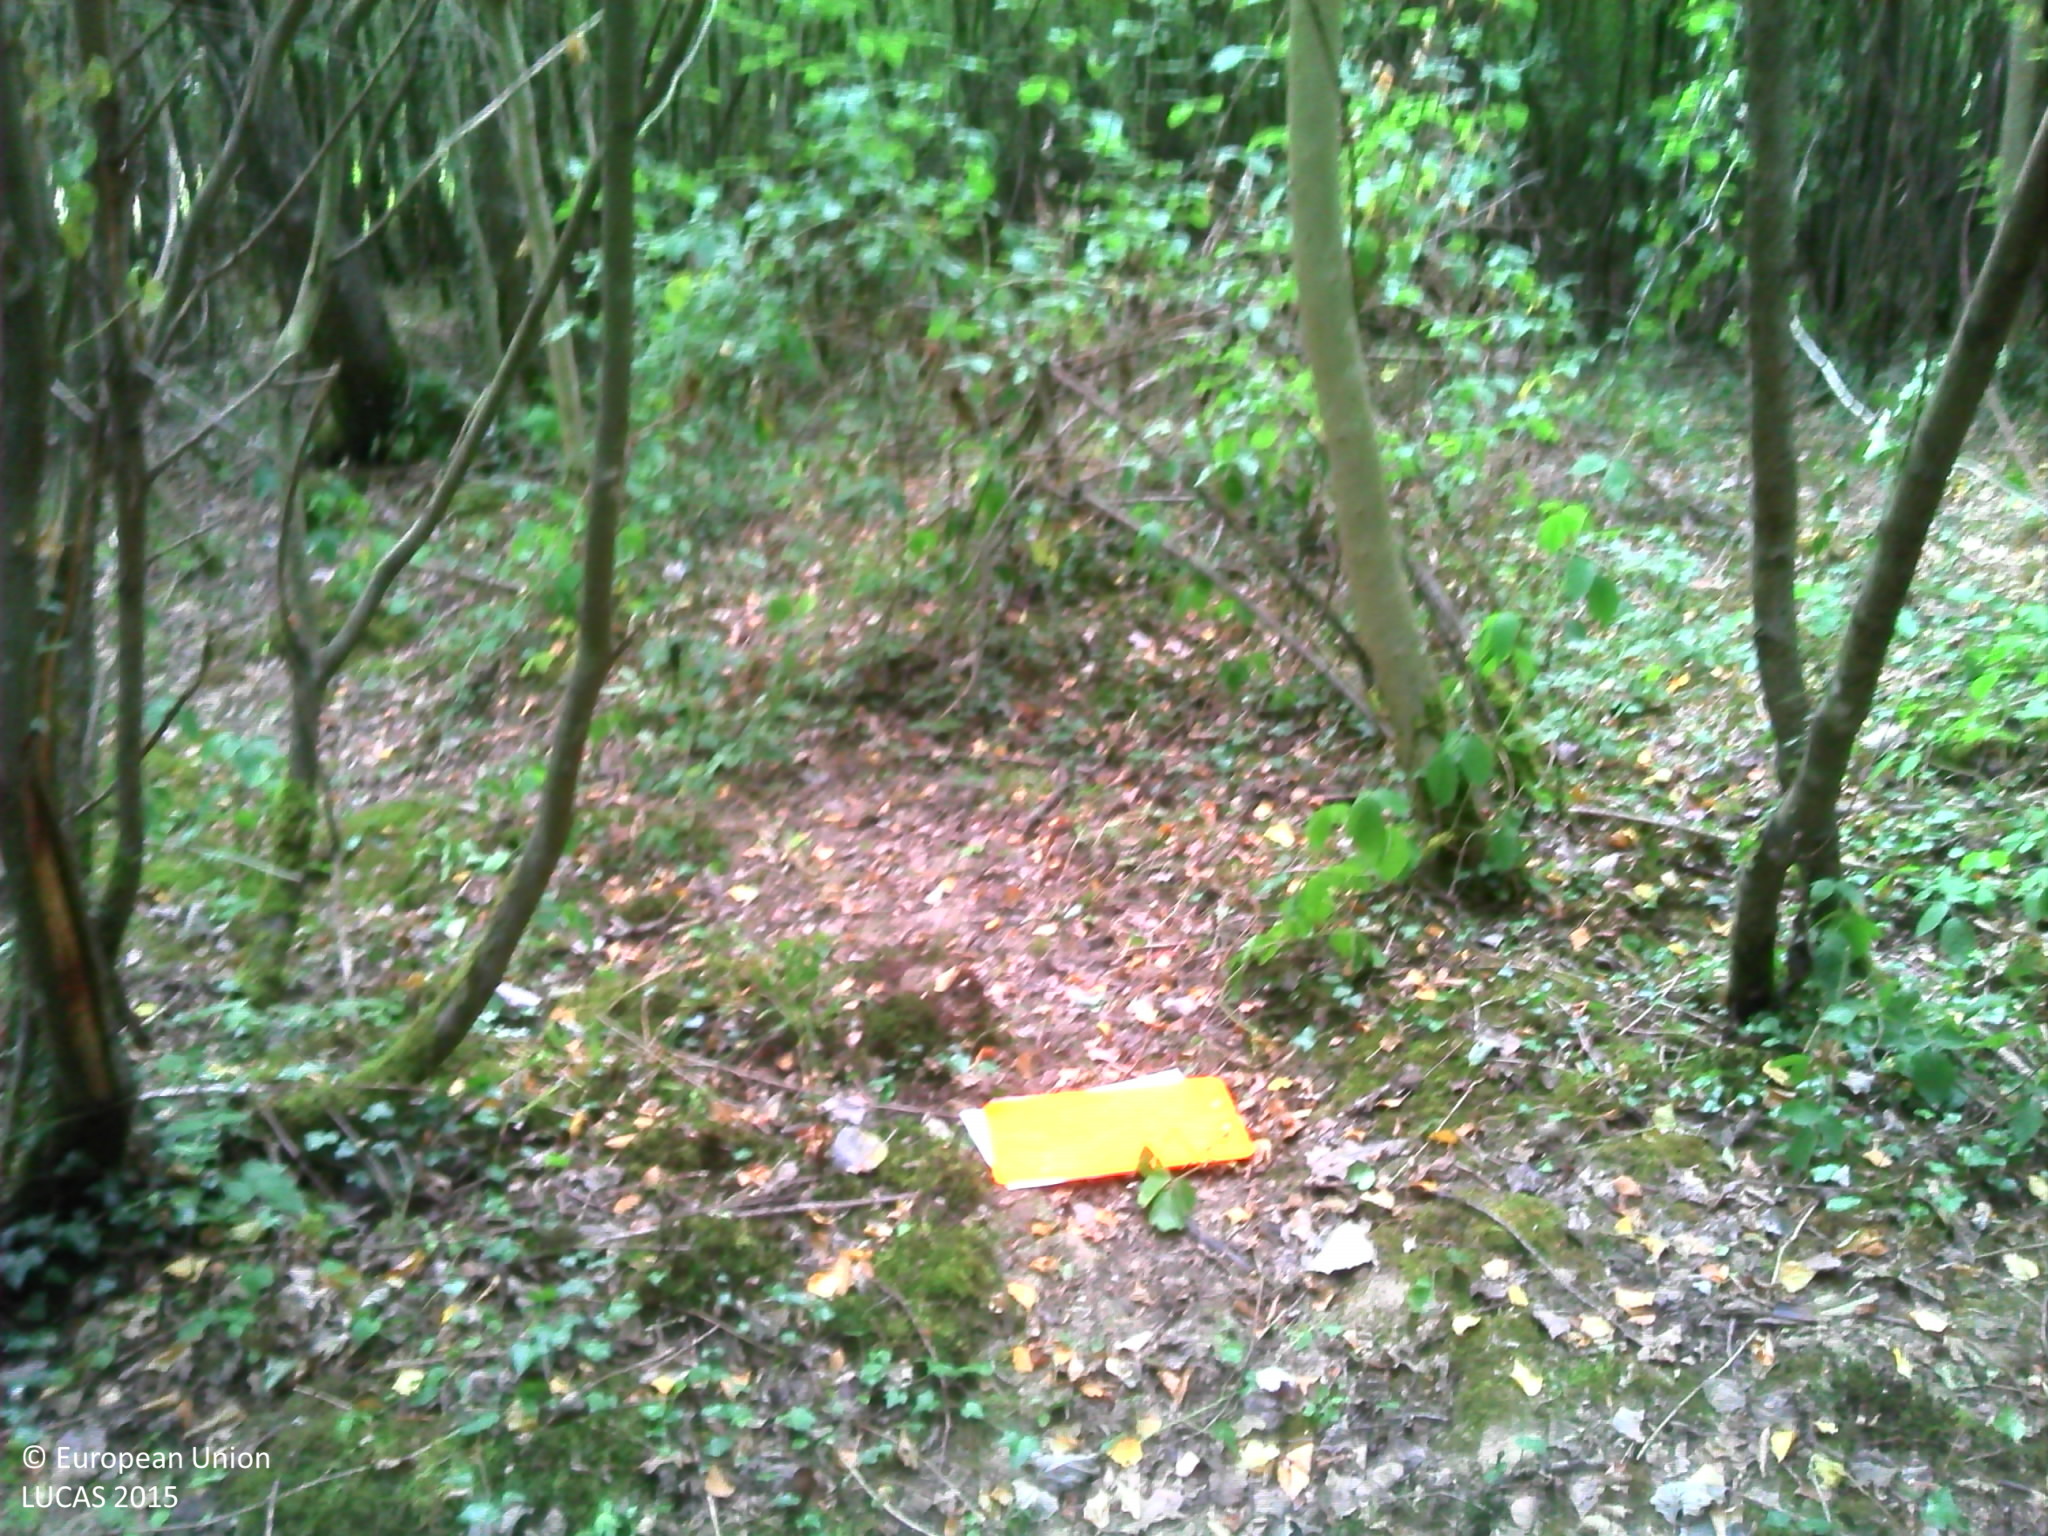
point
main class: Woodland
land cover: Broadleaved woodland
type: beech forest
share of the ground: > 75 %
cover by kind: broadleaved forest trees 50 %, lichens and mosses 20 %, herbaceous plants 10 %, unconsolidated bare surface 10 %
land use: Forestry
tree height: > 5 m
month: August
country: FR
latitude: 48.8860
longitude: 3.2965
